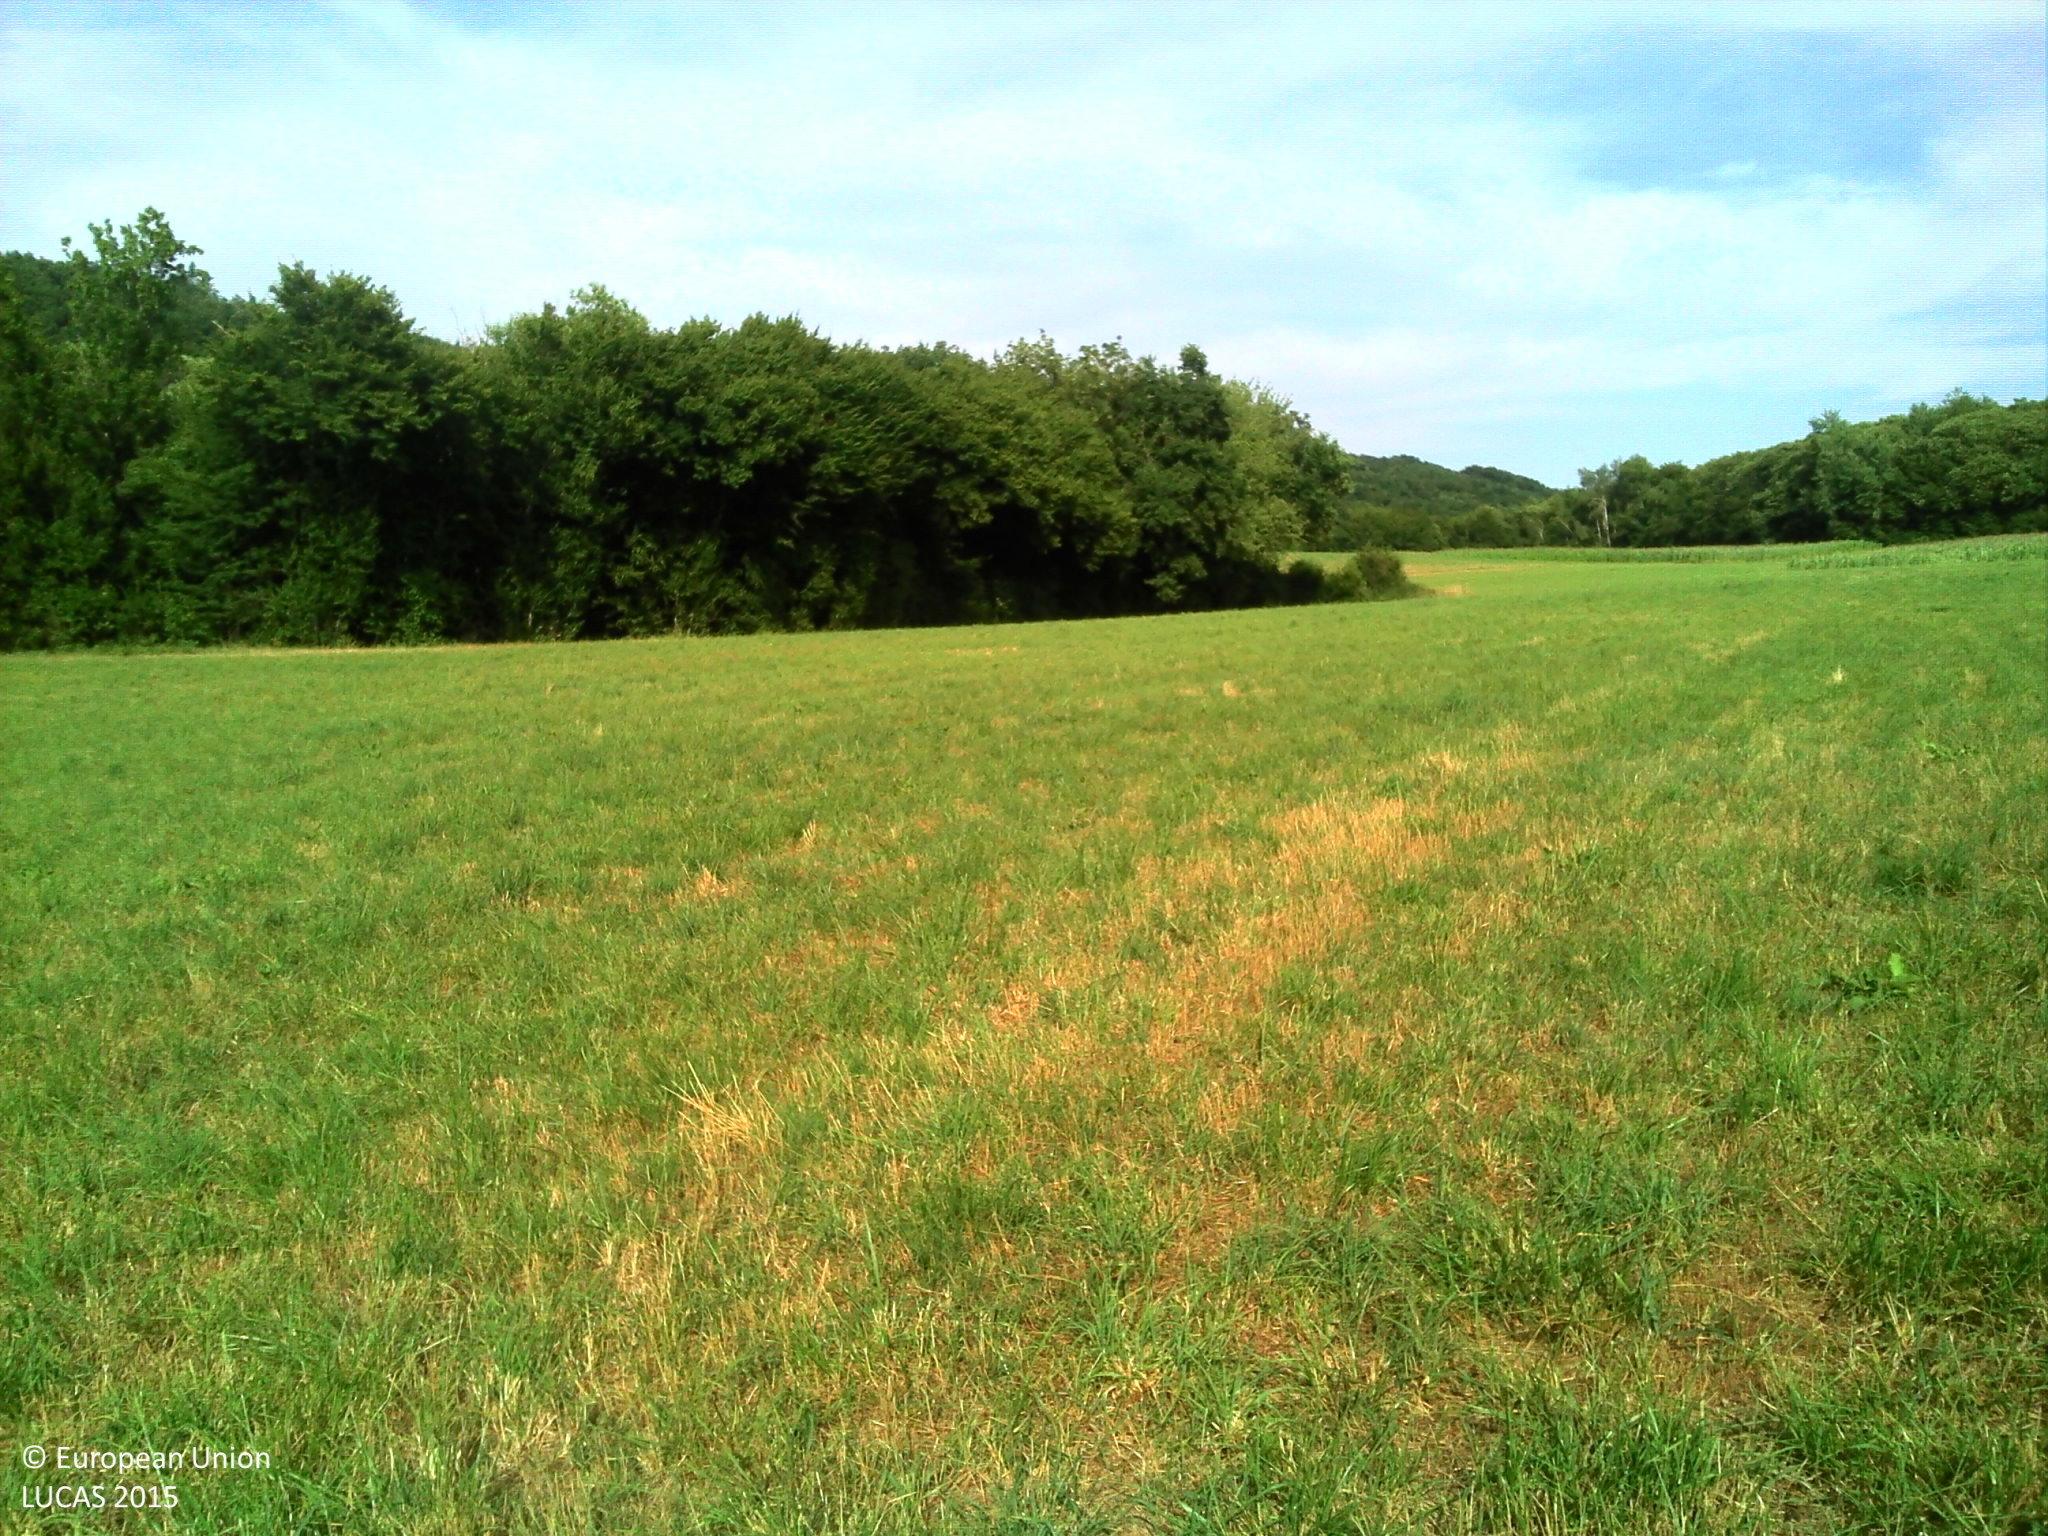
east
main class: Grassland
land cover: Grassland without tree/shrub cover
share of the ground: > 75 %
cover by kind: herbaceous plants 100 %
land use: Agriculture (excluding fallow land and kitchen gardens)
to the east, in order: Grassland without tree/shrub cover; Broadleaved woodland; Grassland without tree/shrub cover
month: July
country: FR
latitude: 45.6028
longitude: 5.4016
